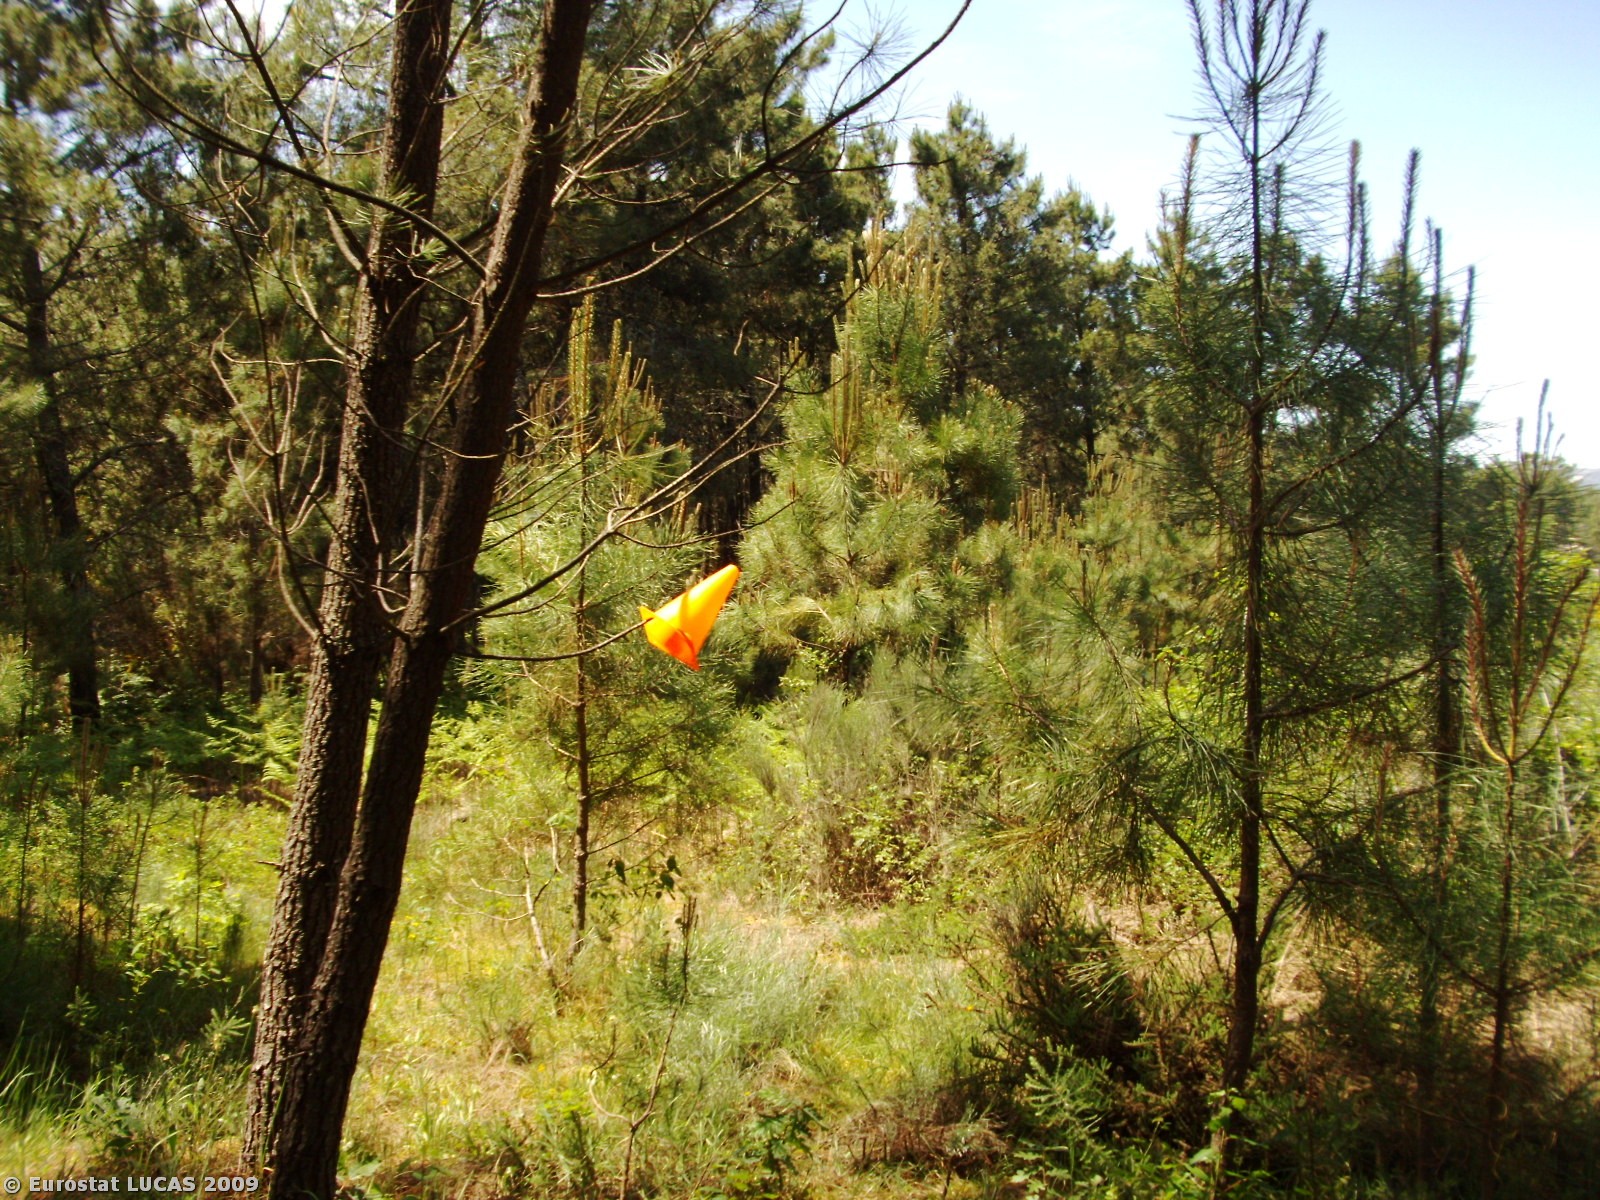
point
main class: Woodland
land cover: Coniferous woodland
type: coniferous forest of the mediterranean region
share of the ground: 50 - 75 %
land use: Forestry
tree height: > 5 m
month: May
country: PT
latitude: 40.7670
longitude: -7.4947
